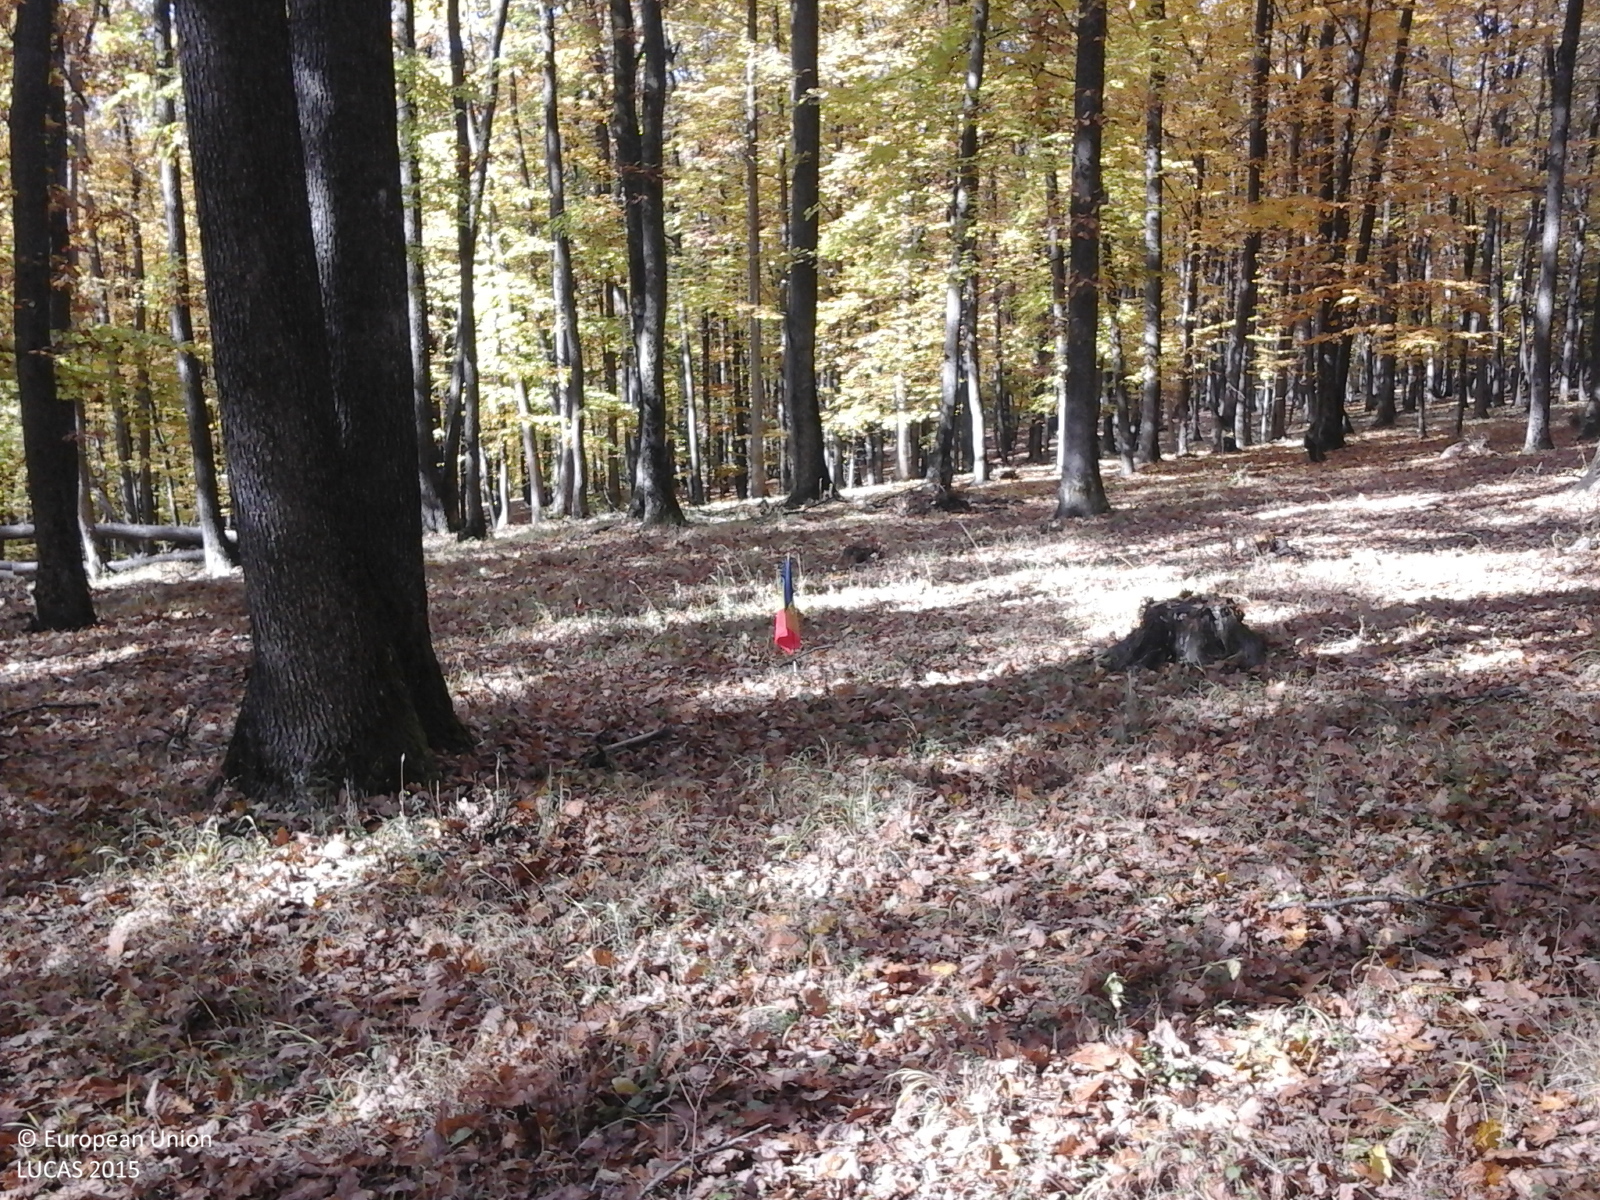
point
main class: Woodland
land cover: Broadleaved woodland
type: acidophilous oak and oak-birch forest
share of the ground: > 75 %
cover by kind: broadleaved forest trees 100 %
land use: Forestry
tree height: > 5 m
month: October
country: RO
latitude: 46.0563
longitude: 27.0390
